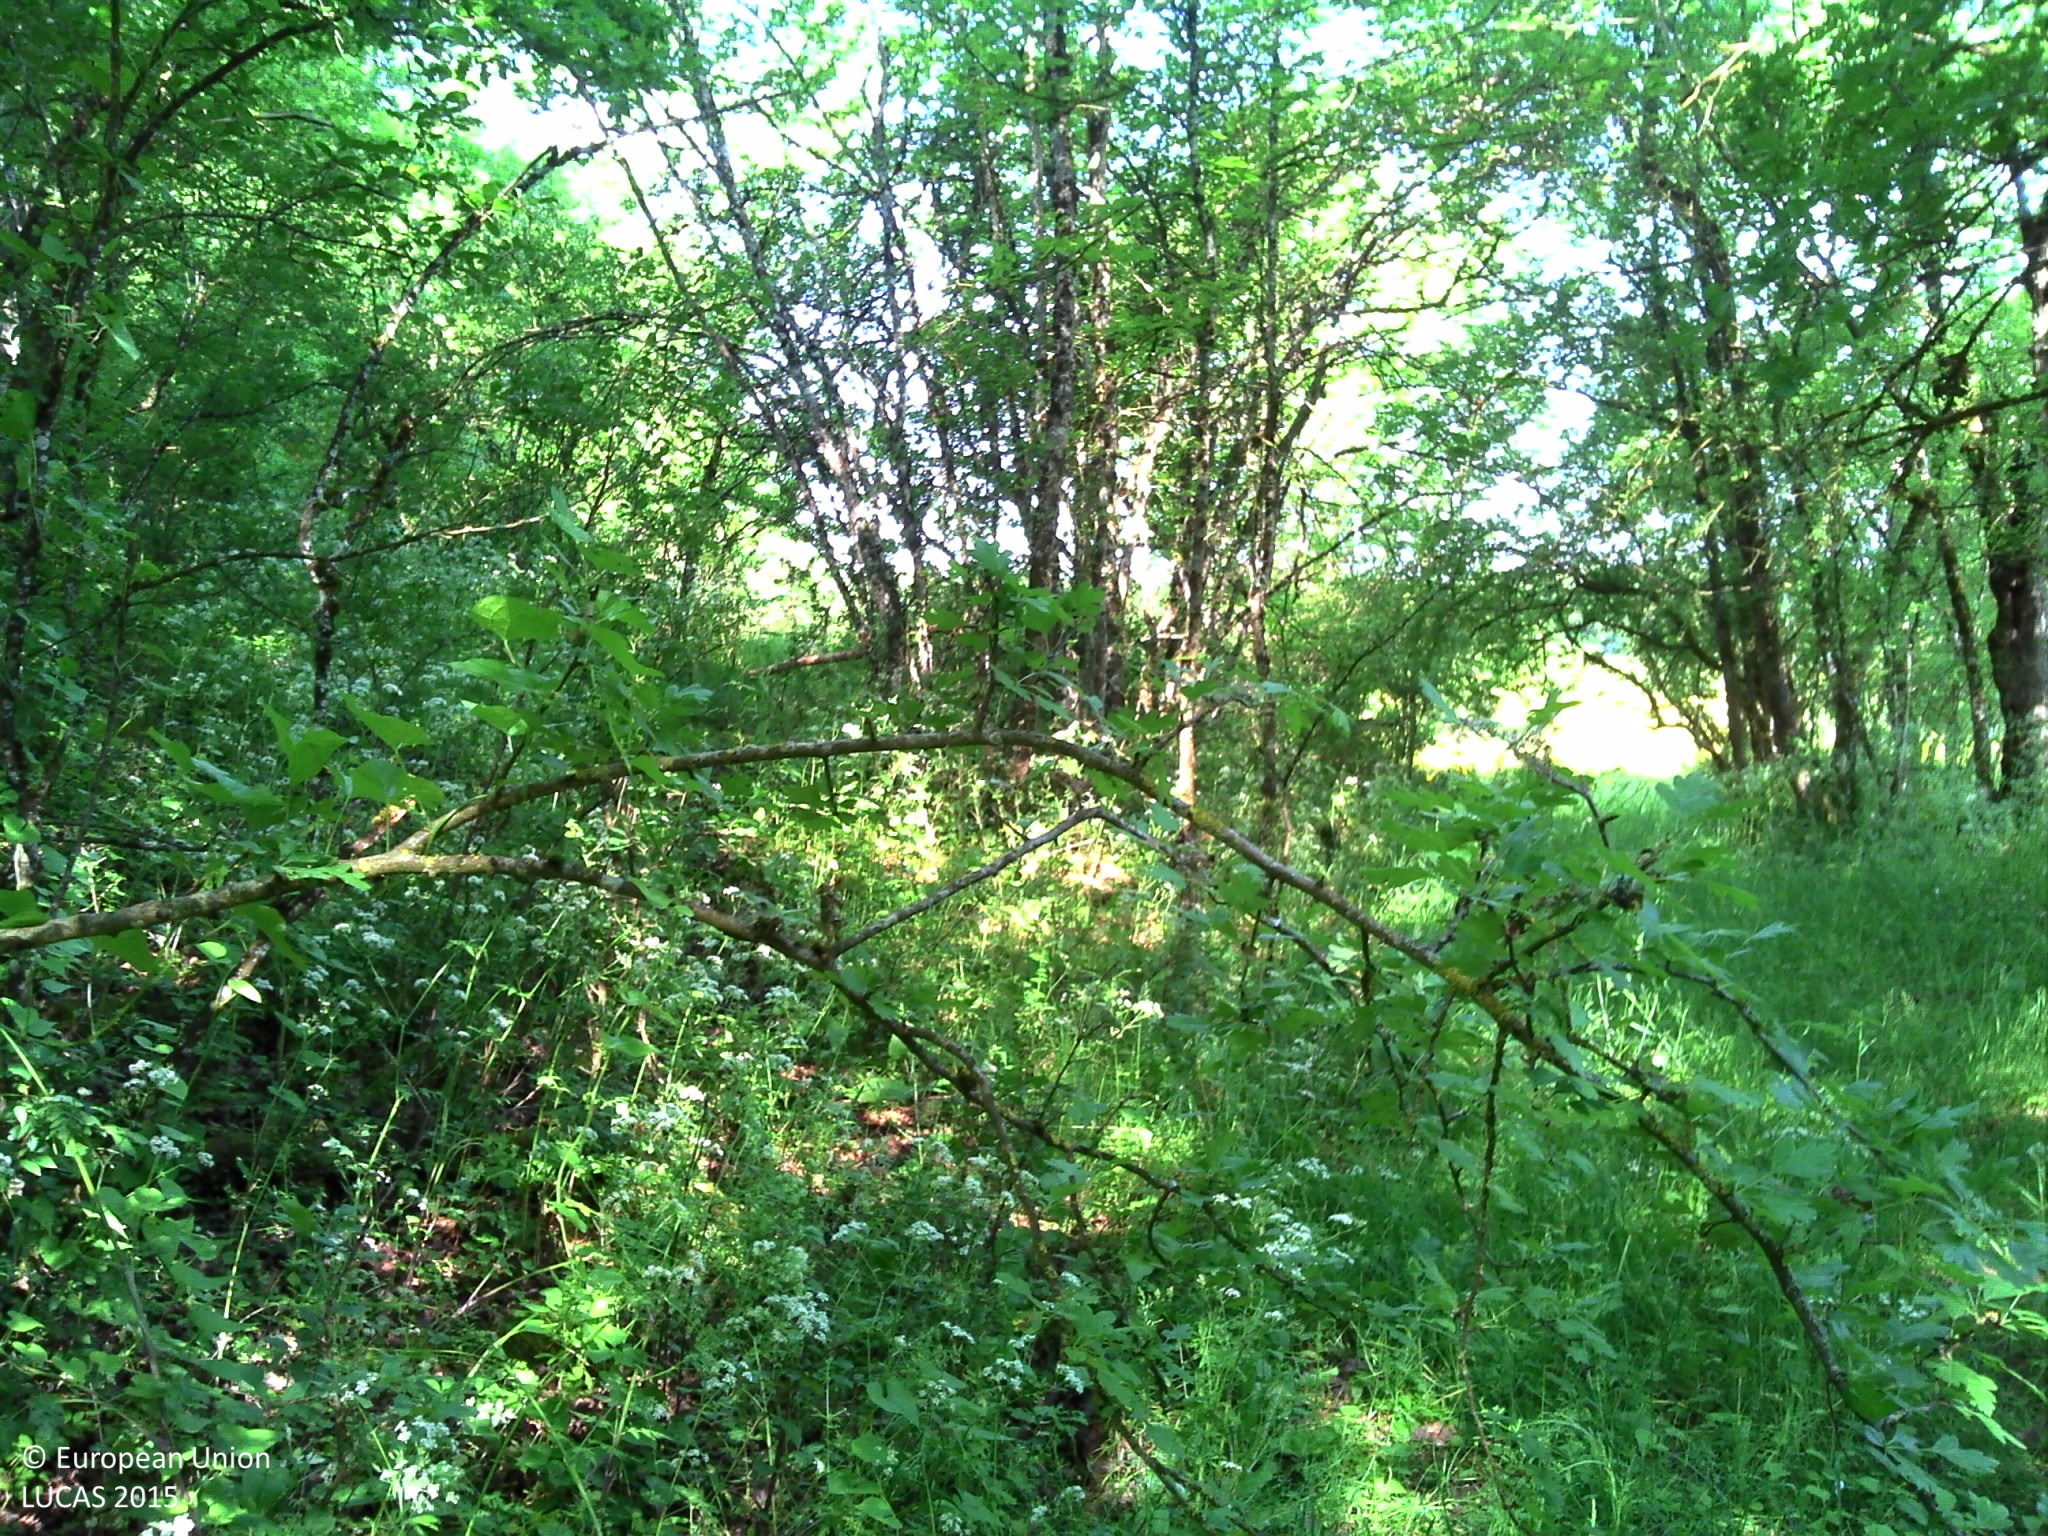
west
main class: Woodland
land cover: Broadleaved woodland
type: acidophilous oak and oak-birch forest
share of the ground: > 75 %
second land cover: Grassland without tree/shrub cover
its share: 50 - 75 %
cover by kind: broadleaved forest trees 60 %, herbaceous plants 35 %, lichens and mosses 5 %
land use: Forestry
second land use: Agriculture (excluding fallow land and kitchen gardens)
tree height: > 5 m
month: May
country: FR
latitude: 44.3910
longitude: 2.5589
